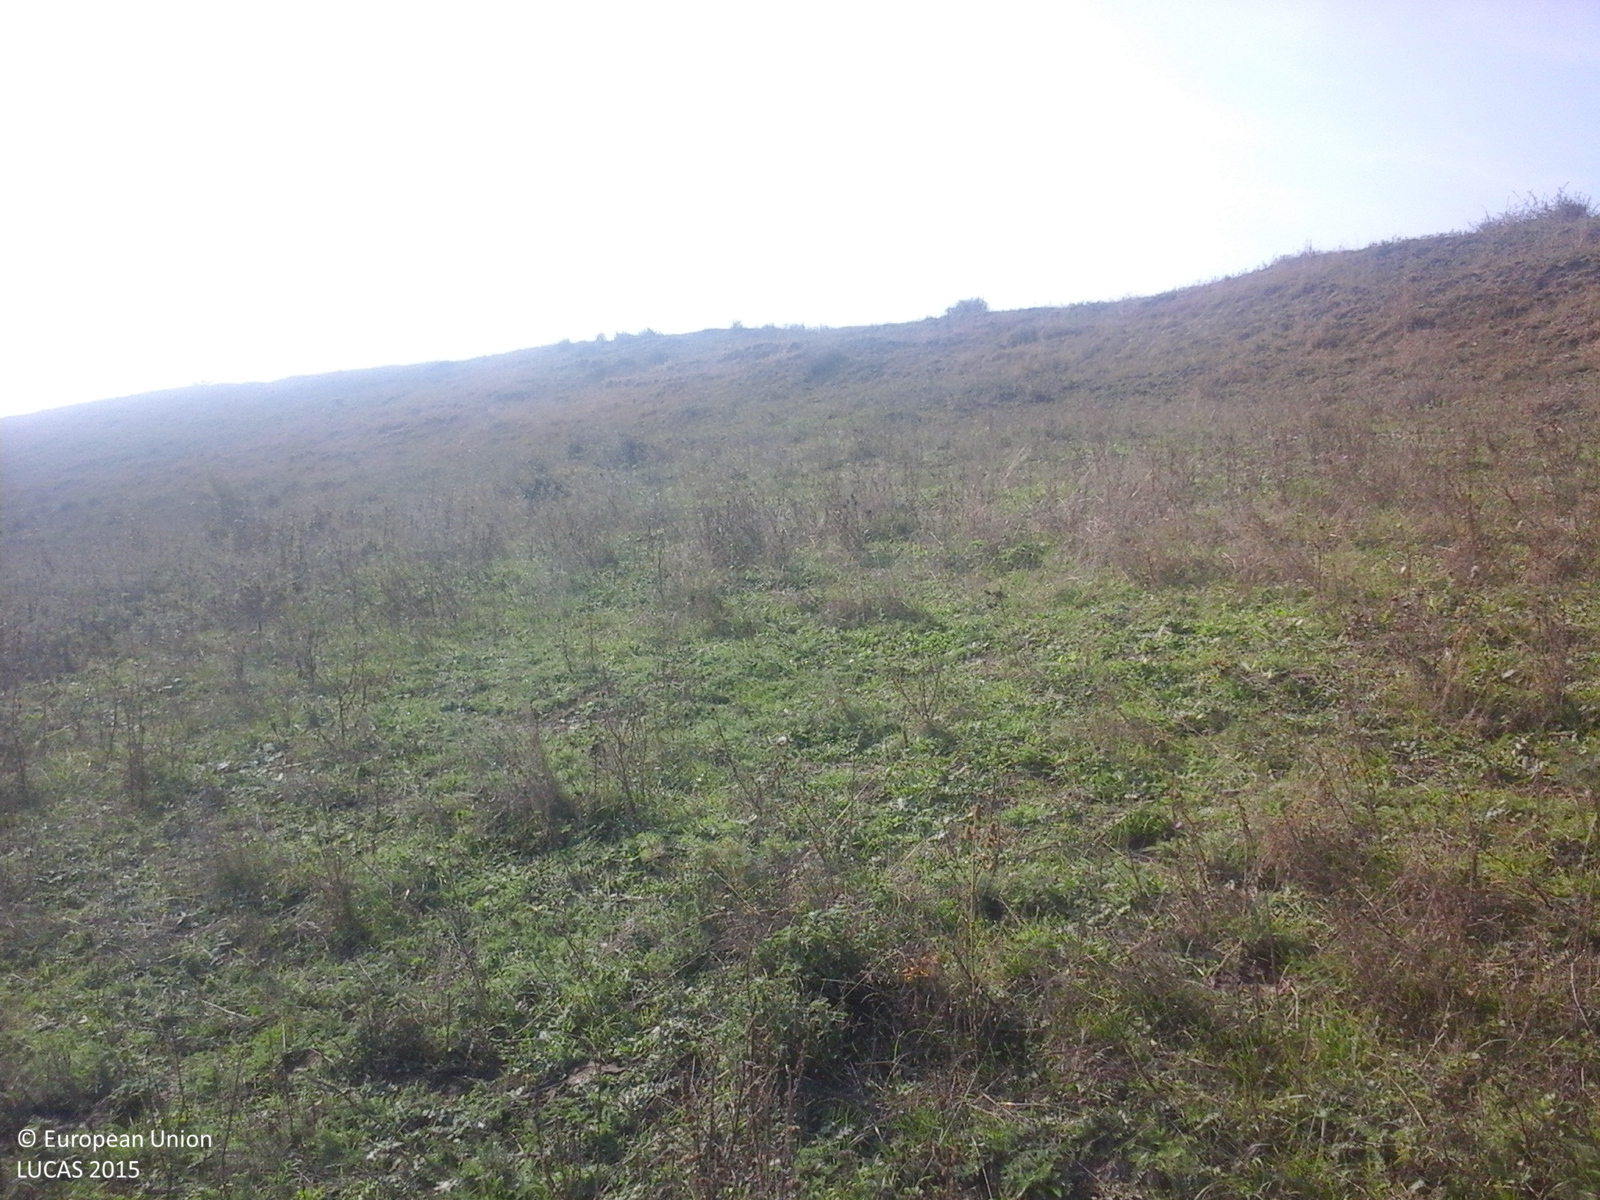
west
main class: Grassland
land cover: Spontaneously vegetated surfaces
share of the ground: > 75 %
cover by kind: herbaceous plants 100 %
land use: Fallow land
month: October
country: RO
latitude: 46.3288
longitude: 23.9344
